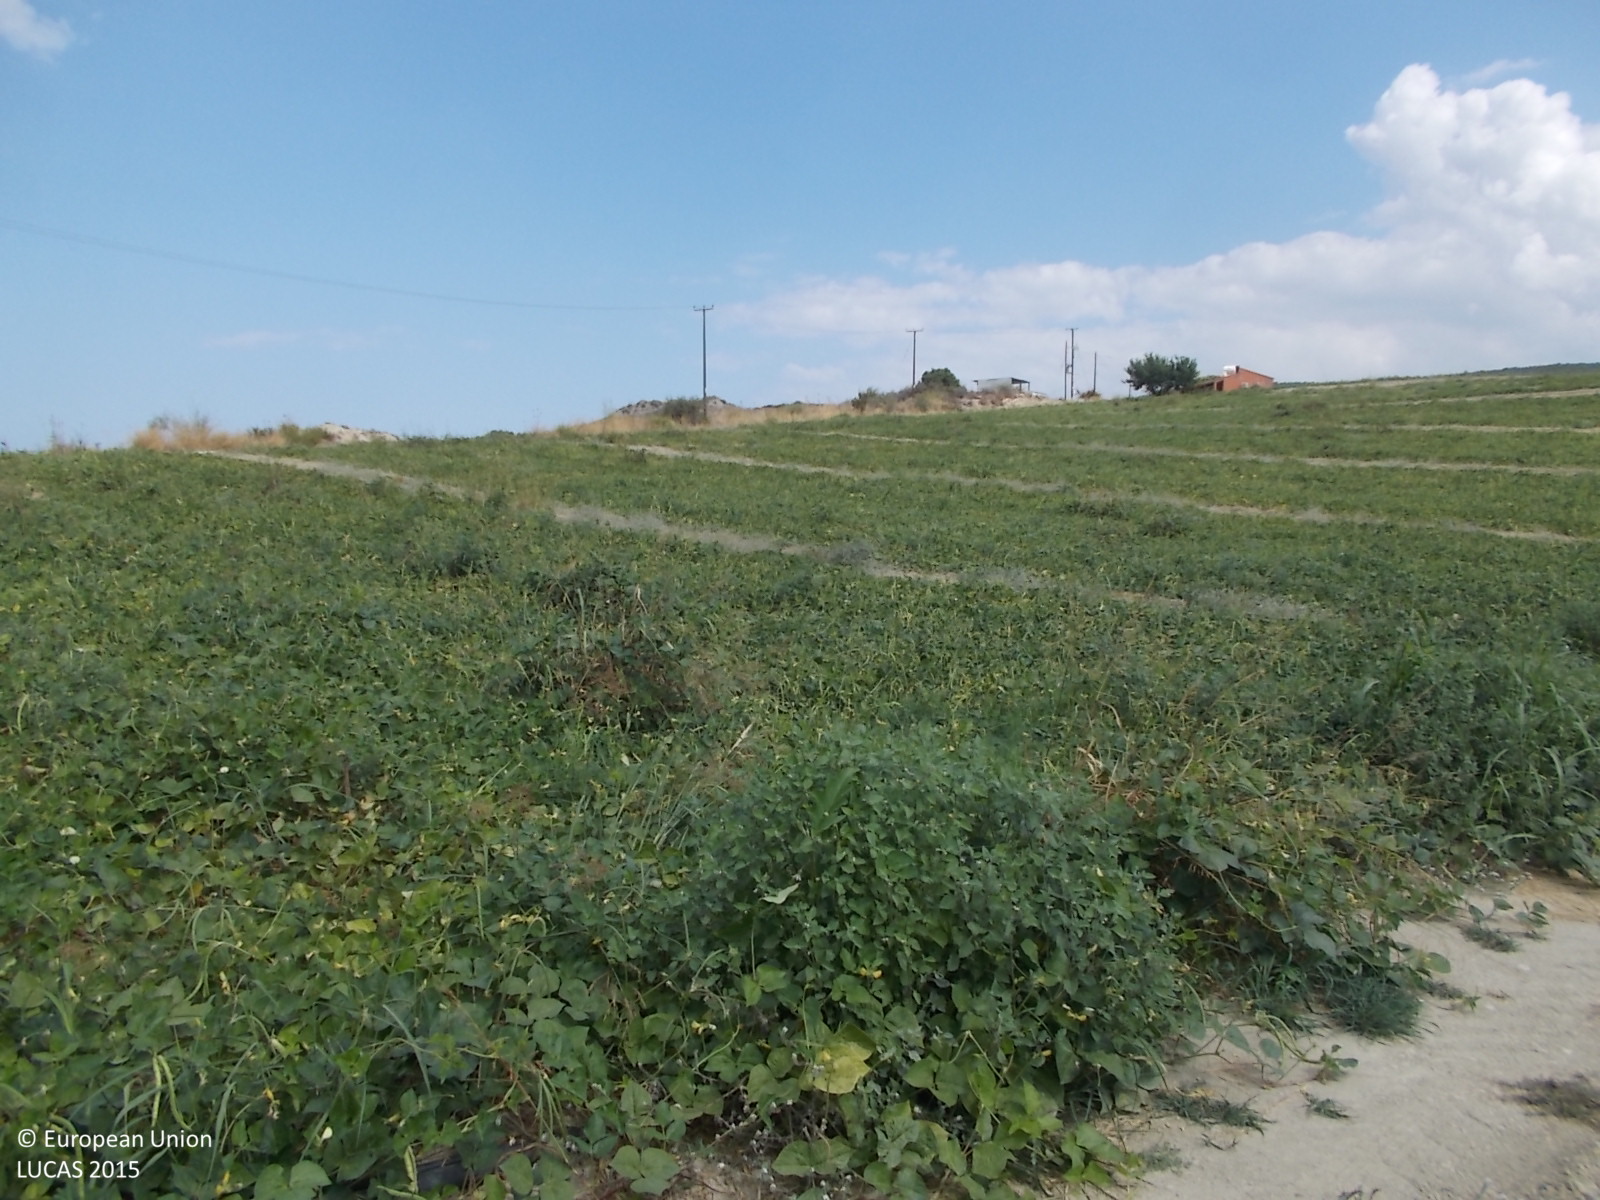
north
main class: Cropland
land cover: Dry pulses
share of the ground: > 75 %
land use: Agriculture (excluding fallow land and kitchen gardens)
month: June
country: CY
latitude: 34.9845
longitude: 32.4679
